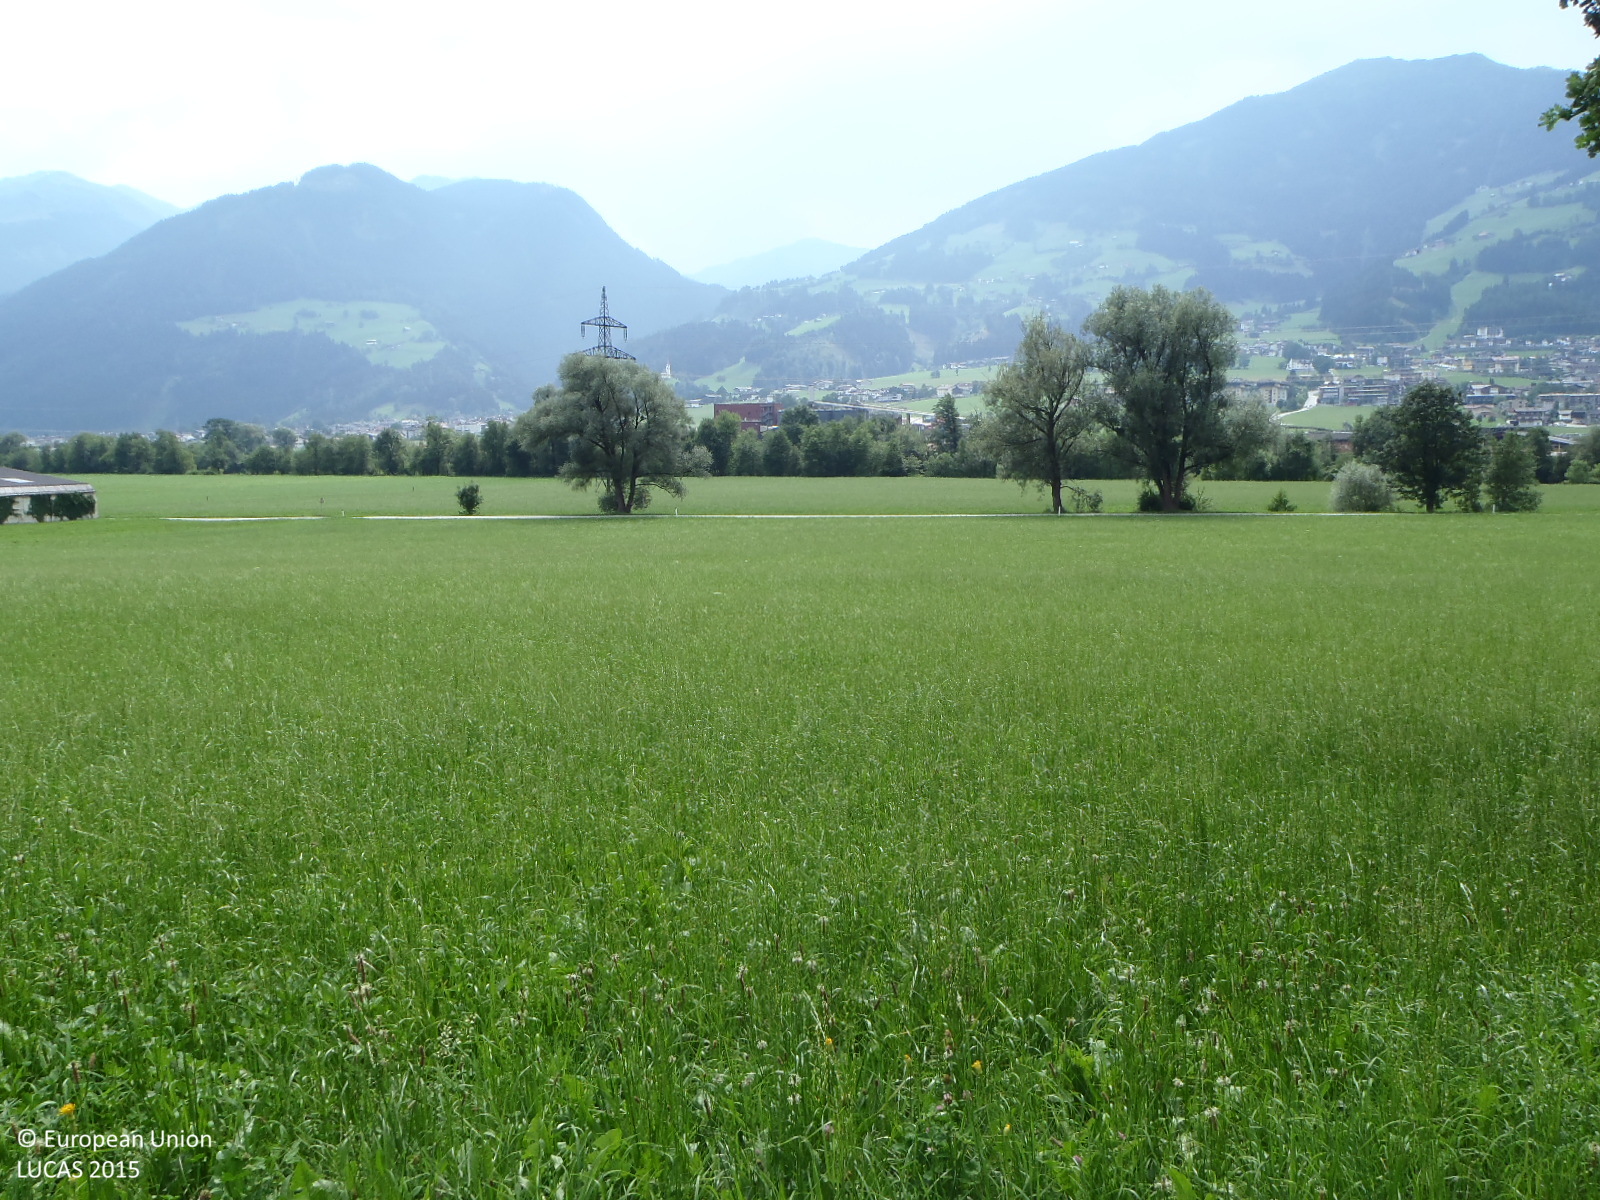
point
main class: Grassland
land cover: Grassland without tree/shrub cover
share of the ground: > 75 %
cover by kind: herbaceous plants 100 %
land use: Agriculture (excluding fallow land and kitchen gardens)
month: July
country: AT
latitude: 47.3436
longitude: 11.8647
